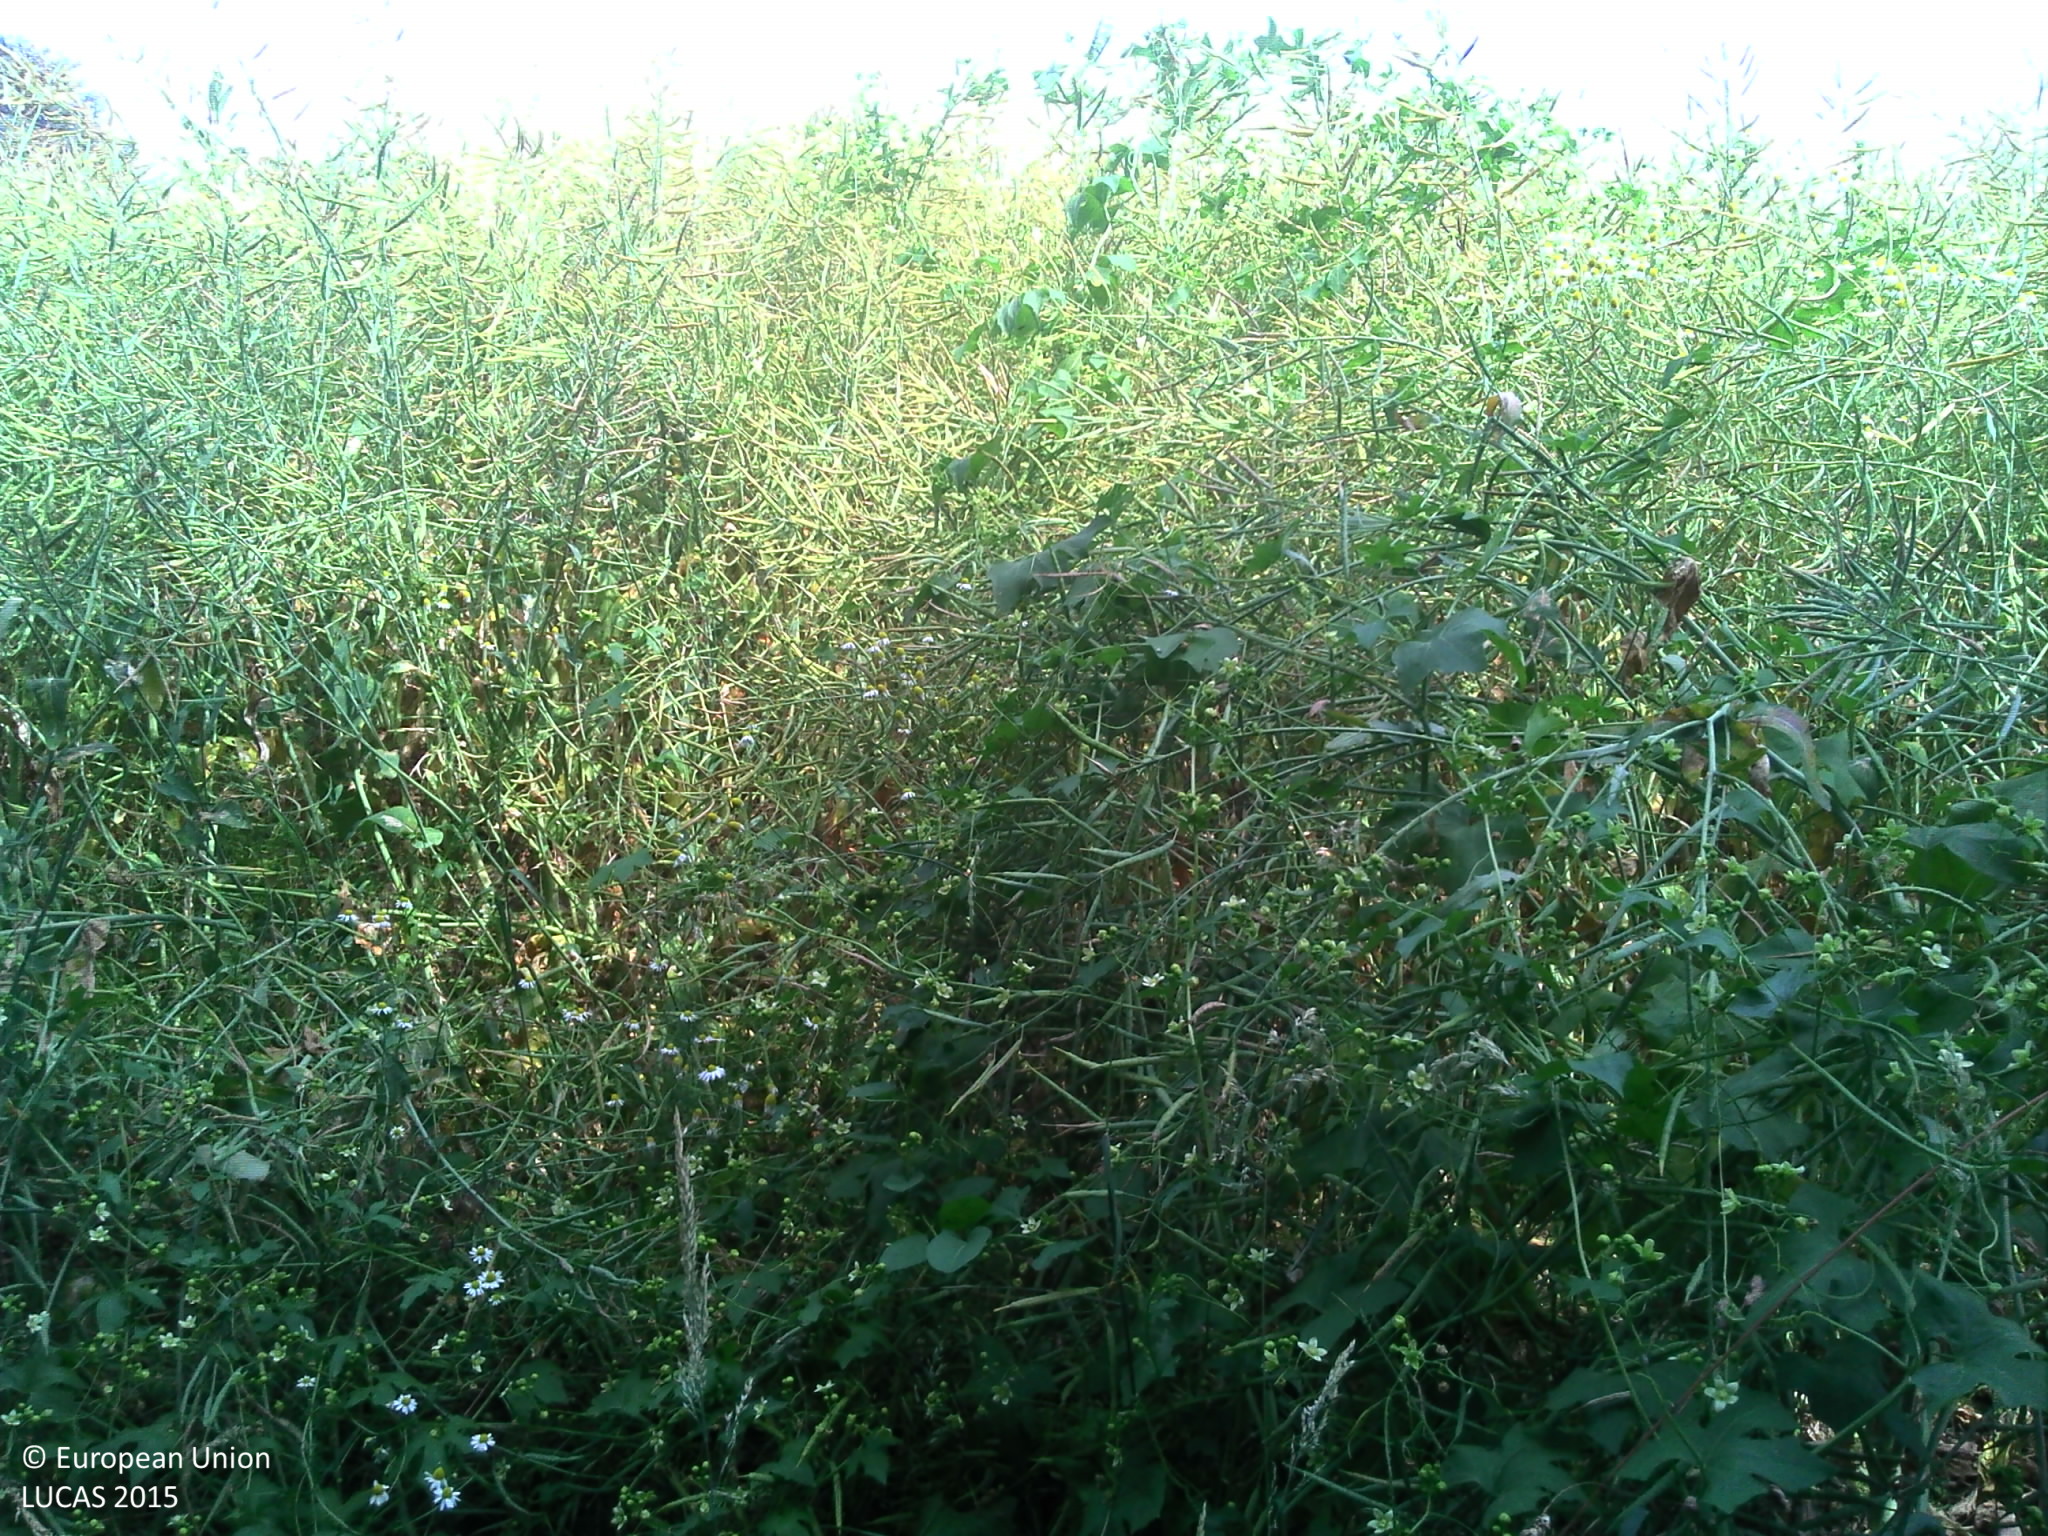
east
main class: Cropland
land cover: Rape and turnip rape
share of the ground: > 75 %
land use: Agriculture (excluding fallow land and kitchen gardens)
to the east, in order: Grass margins; Rape and turnip rape; Fences; Managed hedges; Grassland with sparse tree/shrub cover; Fences; Grass margins; Paved roads, cycling and walking lanes; Grass margins; Fences; Grassland without tree/shrub cover
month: July
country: FR
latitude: 49.1220
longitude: 3.3193
